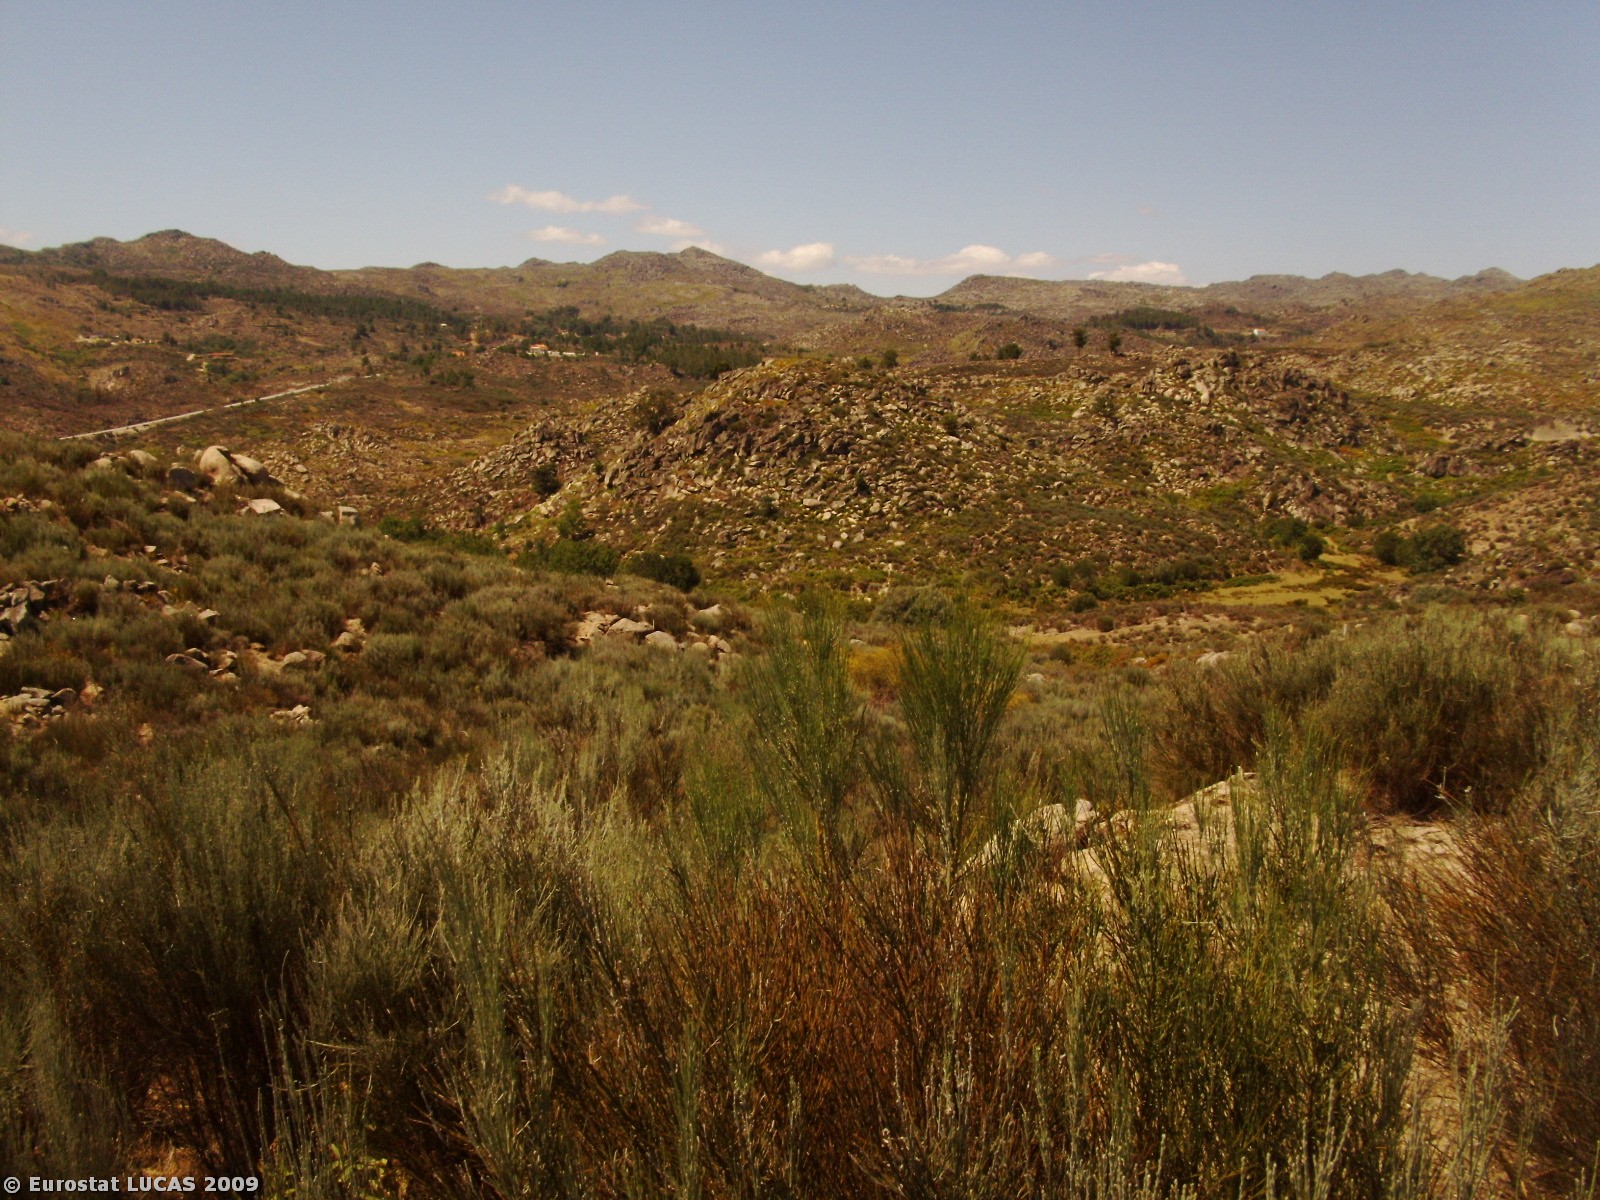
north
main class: Shrubland
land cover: Shrubland without tree cover
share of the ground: > 75 %
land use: Unused
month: July
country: PT
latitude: 40.3878
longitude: -7.2429
